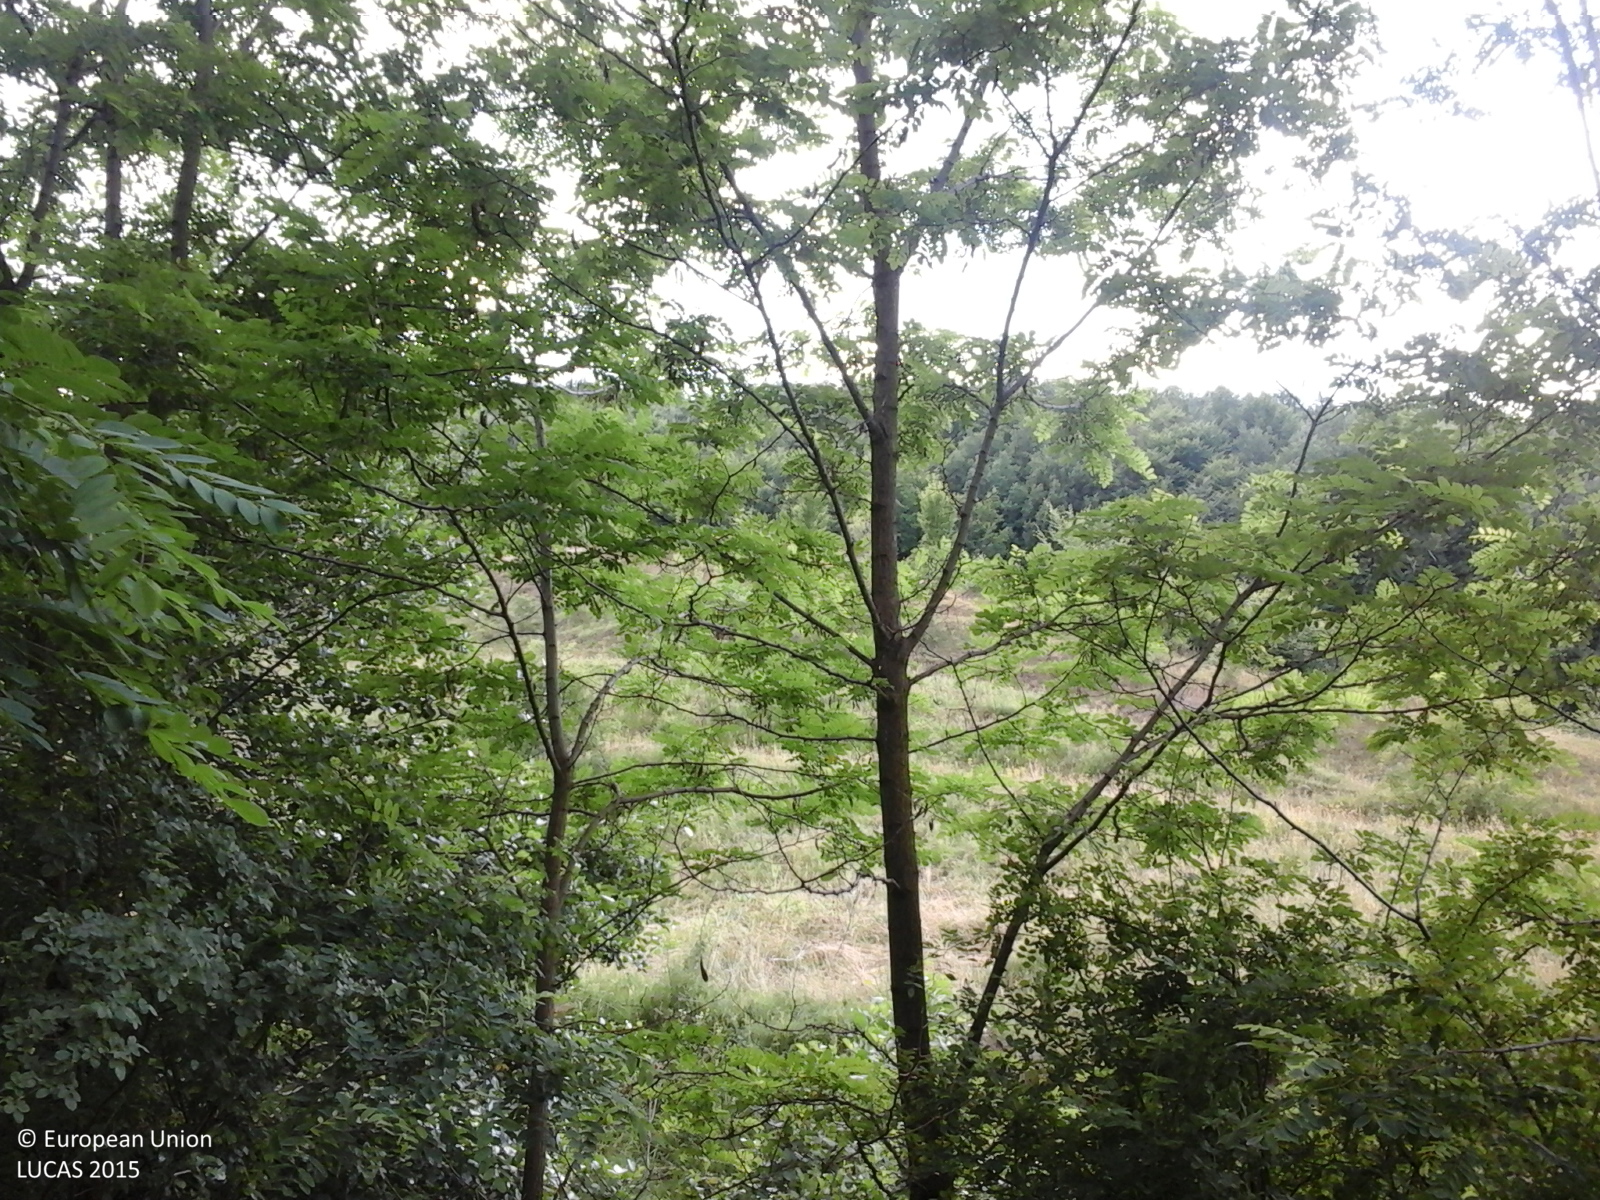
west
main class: Grassland
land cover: Grassland with sparse tree/shrub cover
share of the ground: > 75 %
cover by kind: herbaceous plants 90 %, broadleaved forest trees 5 %, shrubs 5 %
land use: Agriculture (excluding fallow land and kitchen gardens)
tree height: > 5 m
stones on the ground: < 10 %
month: June
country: RO
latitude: 47.4417
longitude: 26.4098
